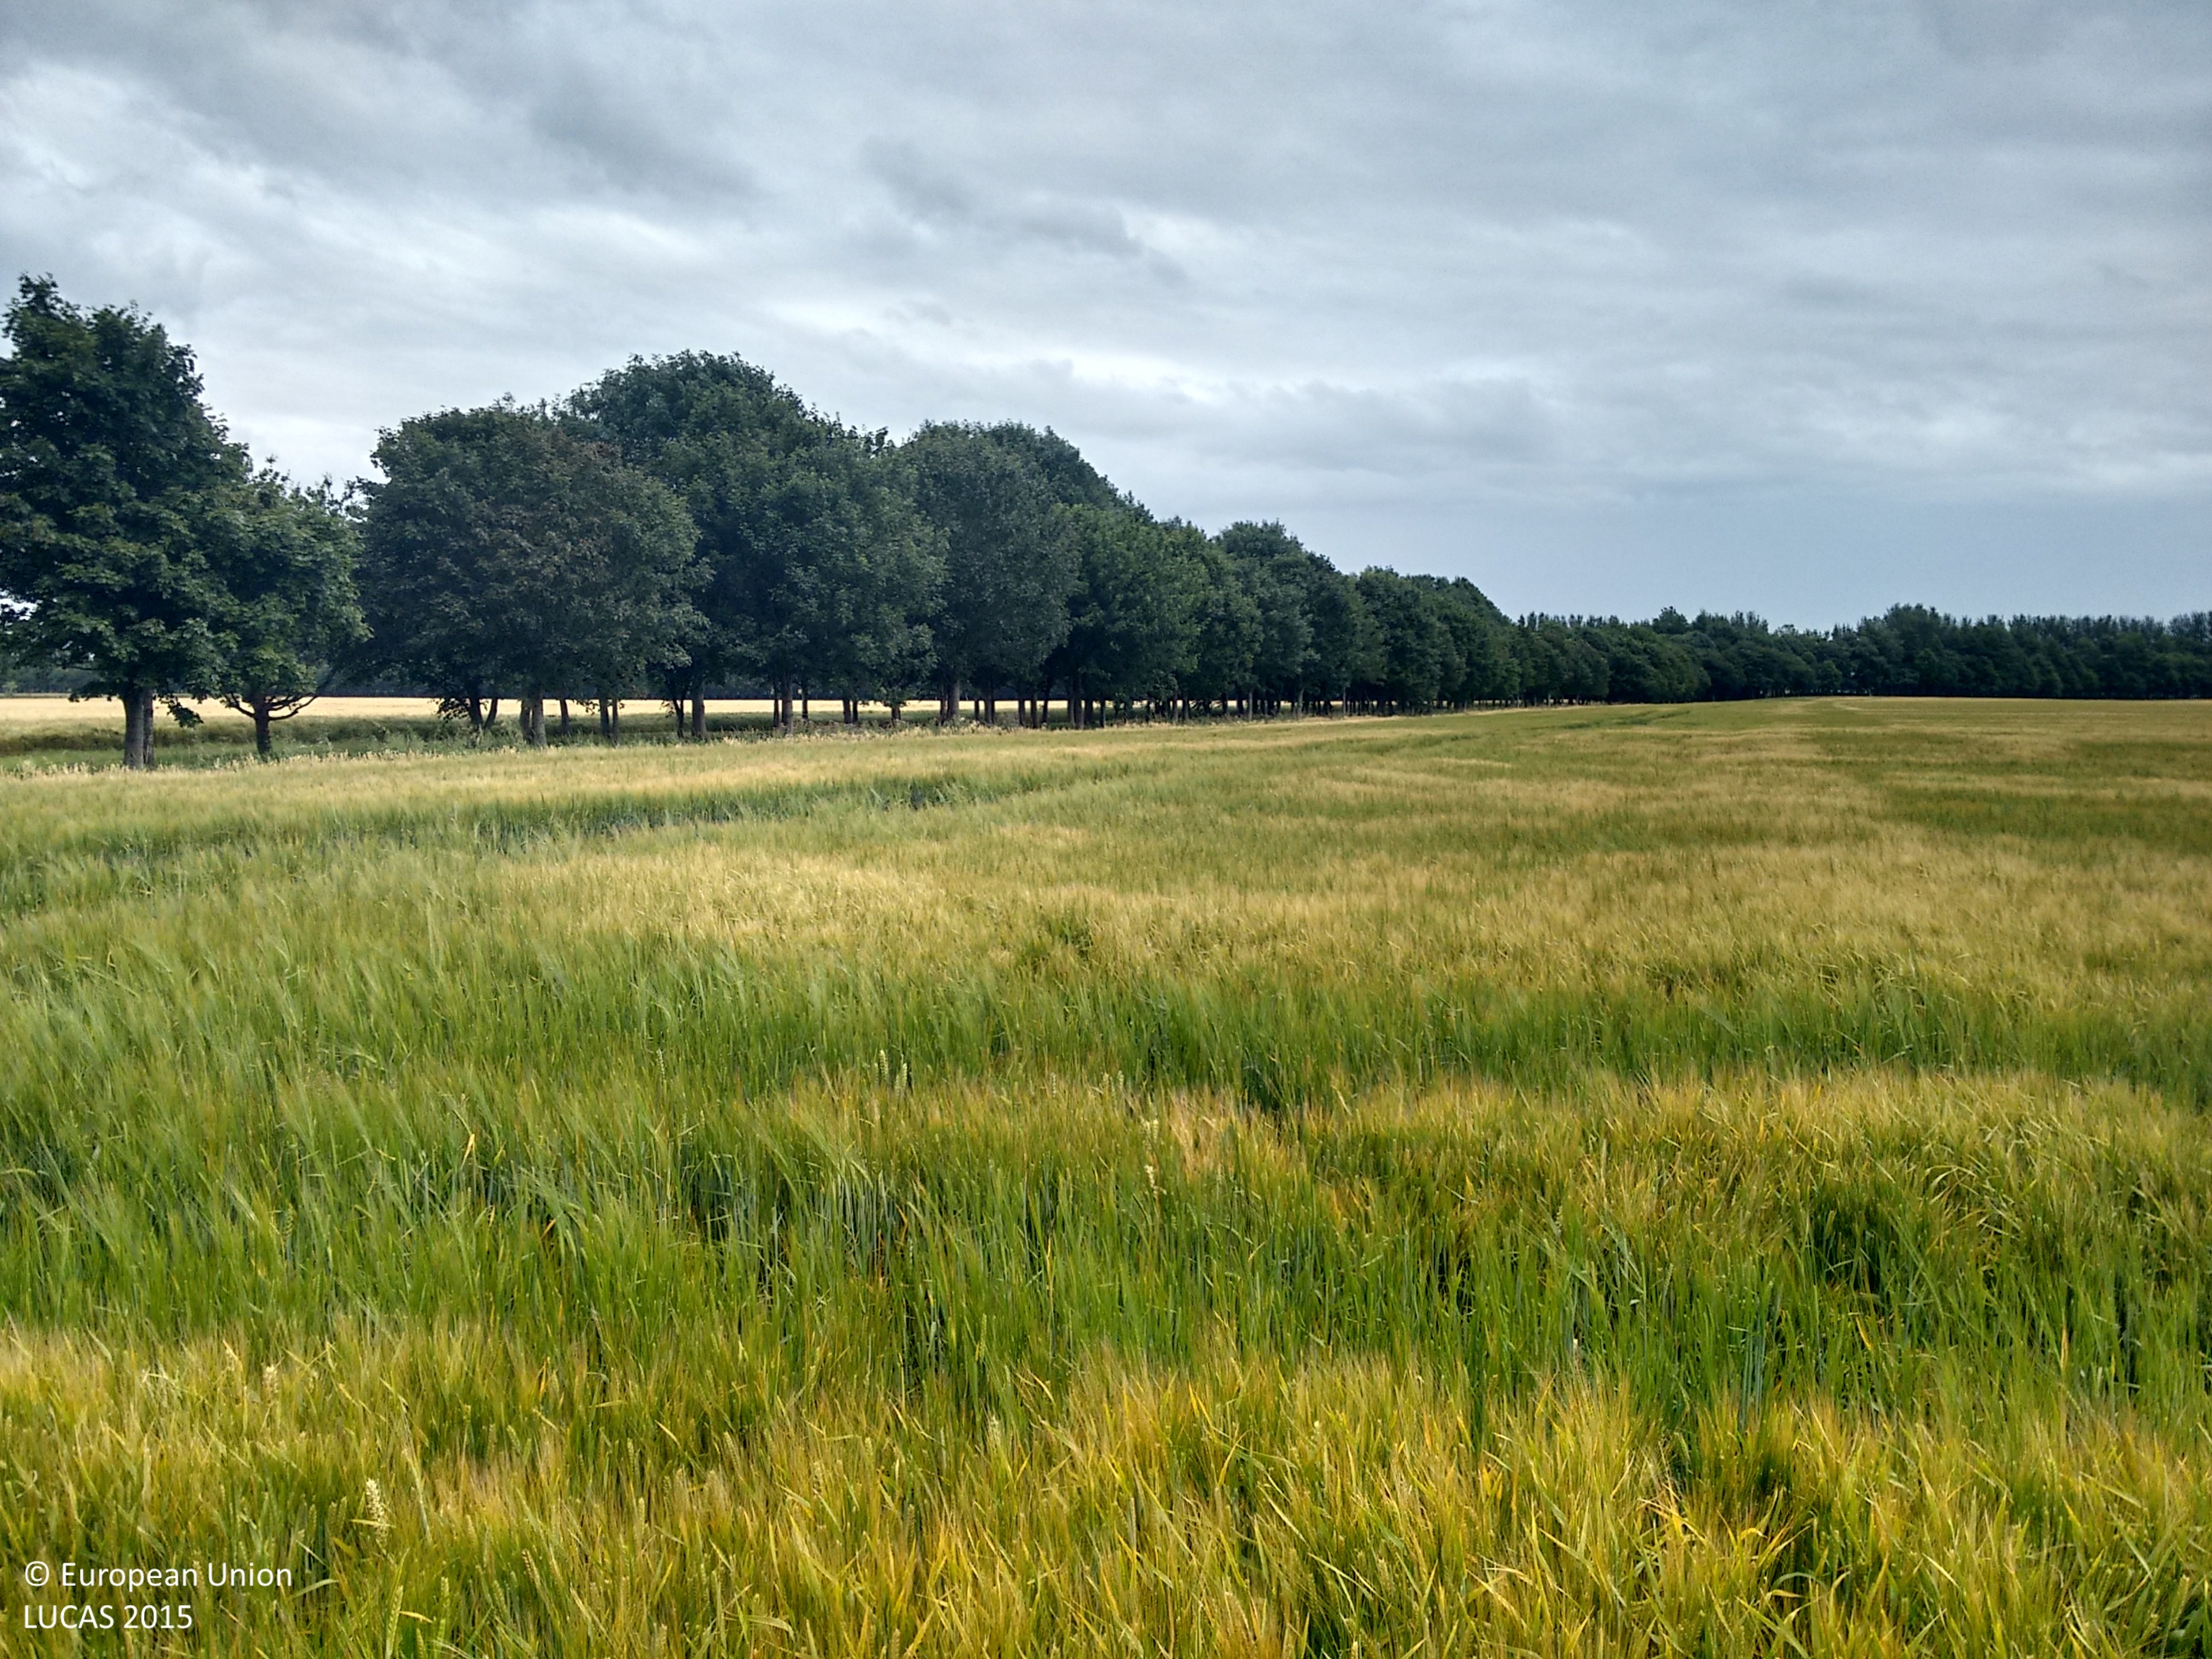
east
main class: Cropland
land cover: Common wheat
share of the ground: > 75 %
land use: Agriculture (excluding fallow land and kitchen gardens)
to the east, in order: Common wheat; Grass margins; Ditches and canals; Grass margins; Broadleaved woodland; Common wheat
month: August
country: IE
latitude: 53.8831
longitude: -6.4479
